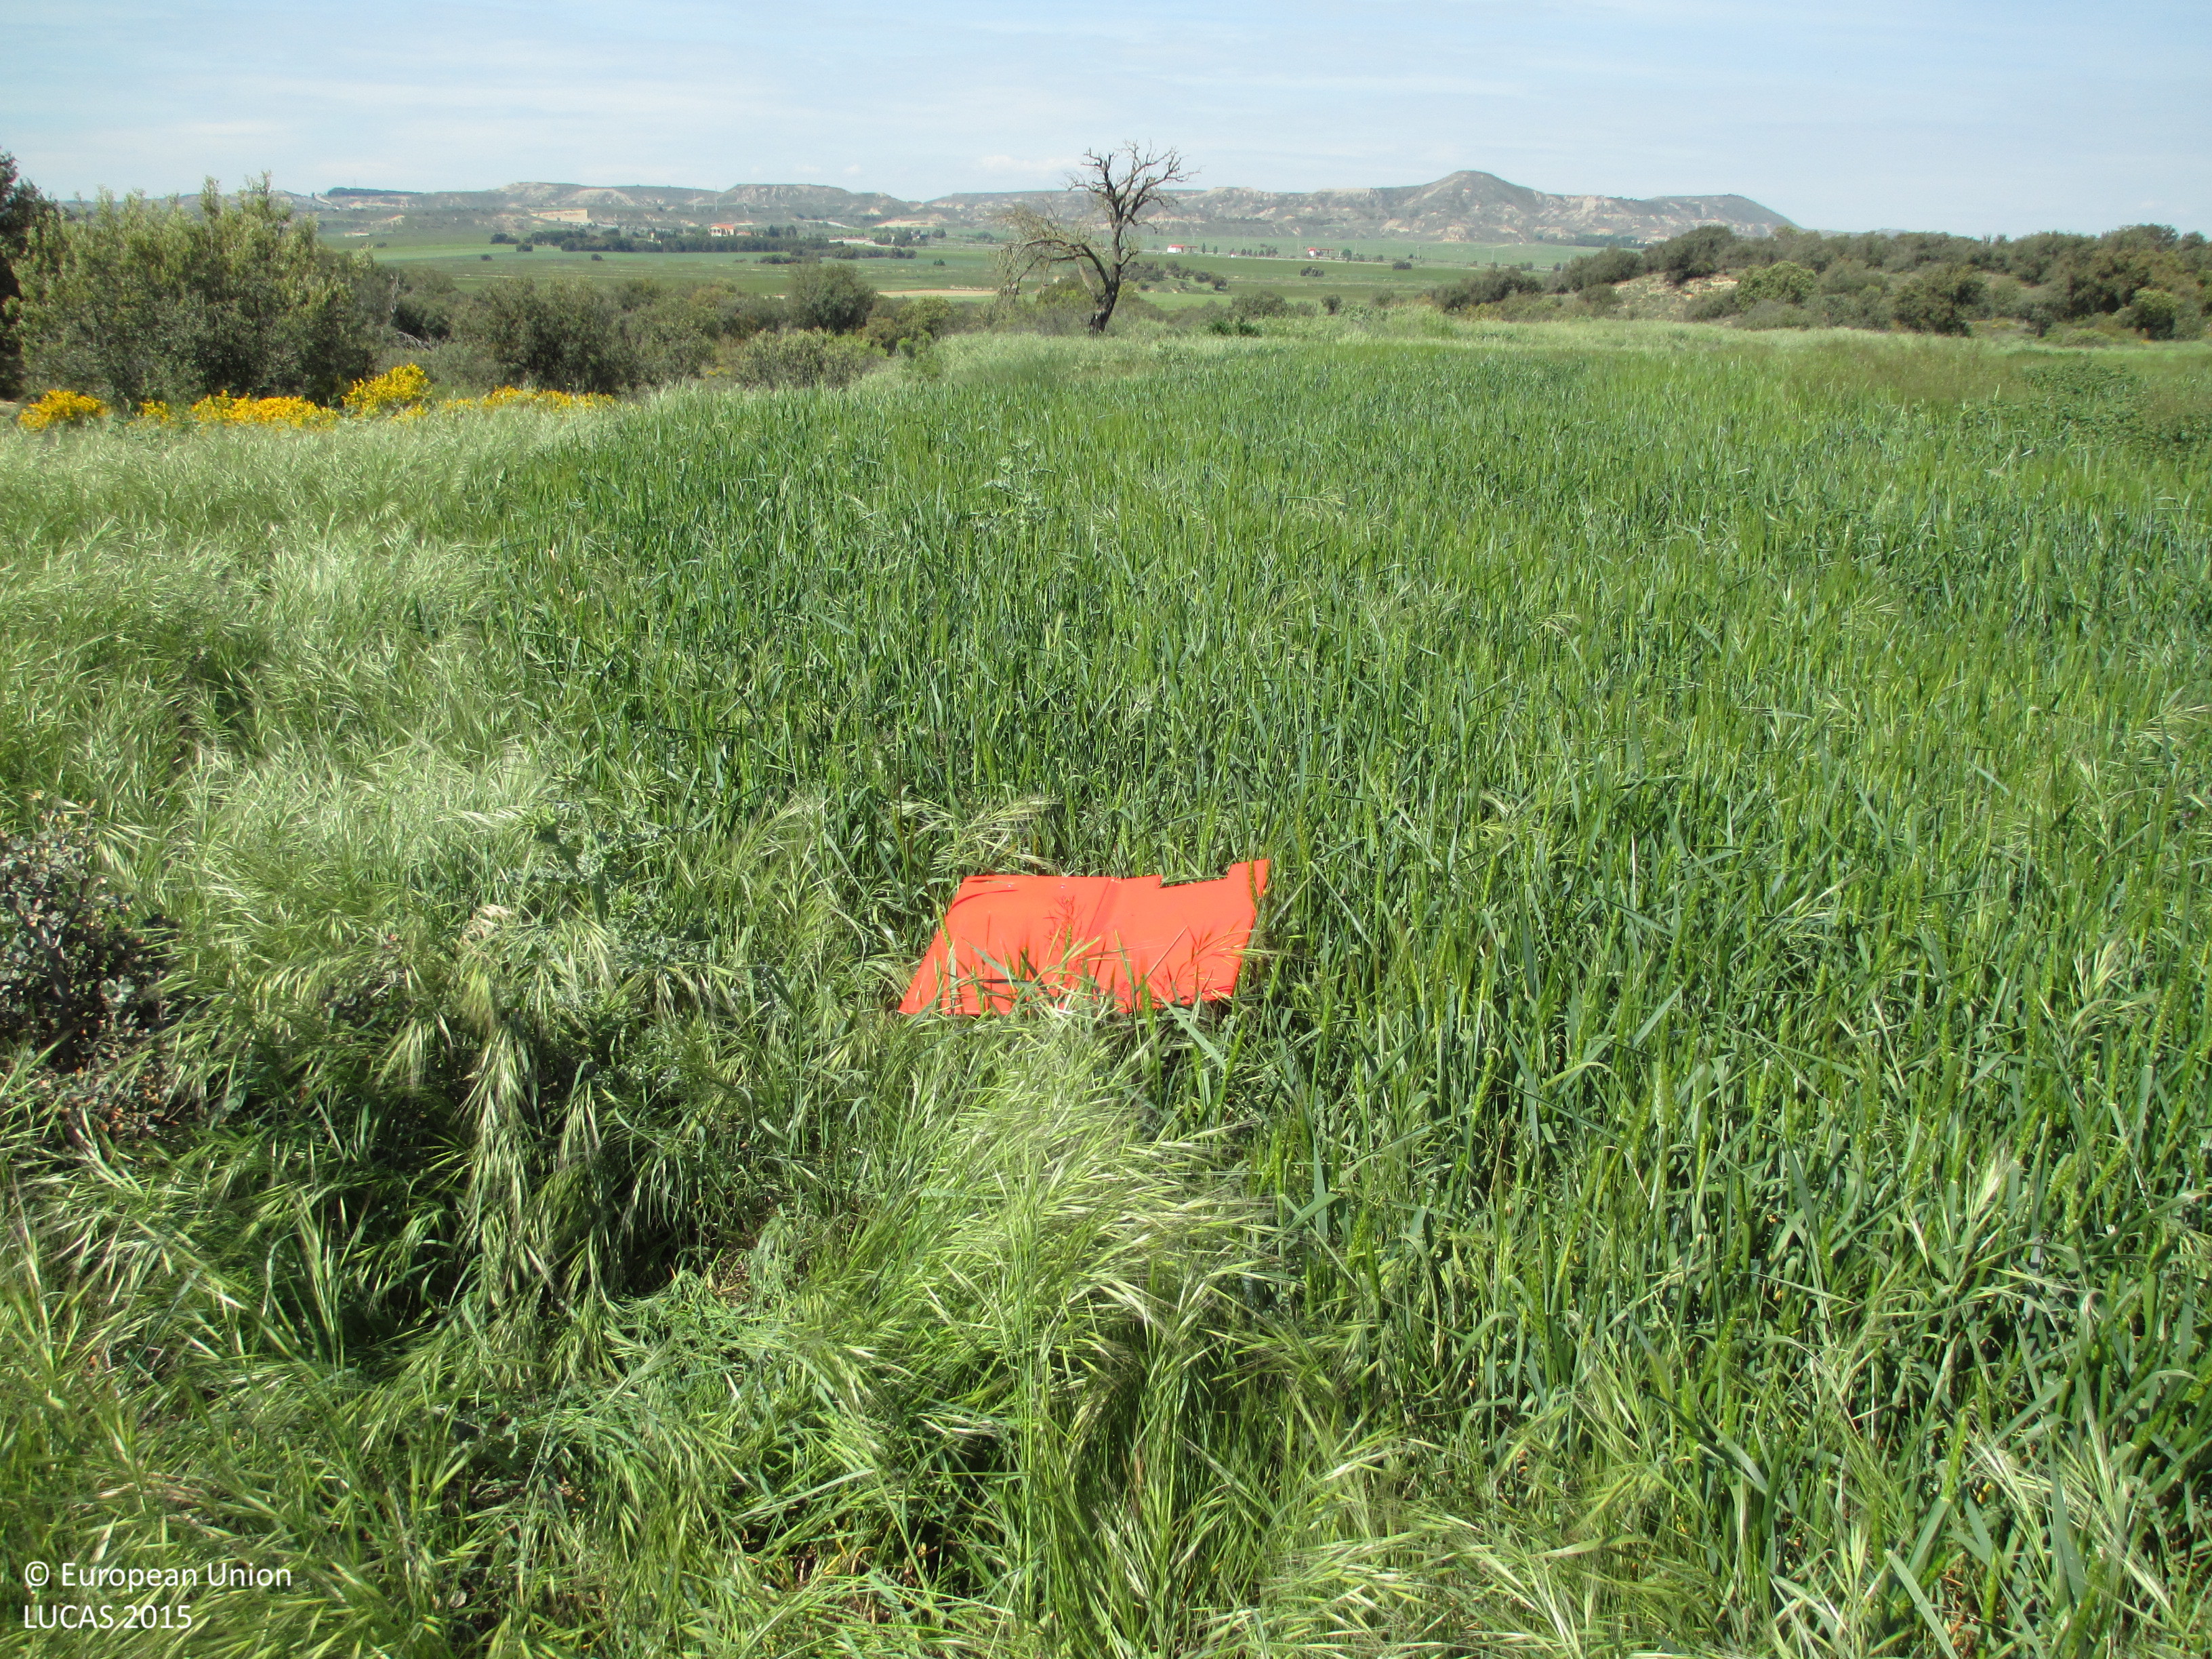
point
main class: Cropland
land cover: Common wheat
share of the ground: > 75 %
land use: Agriculture (excluding fallow land and kitchen gardens)
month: April
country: ES
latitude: 42.0931
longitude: -0.4566
